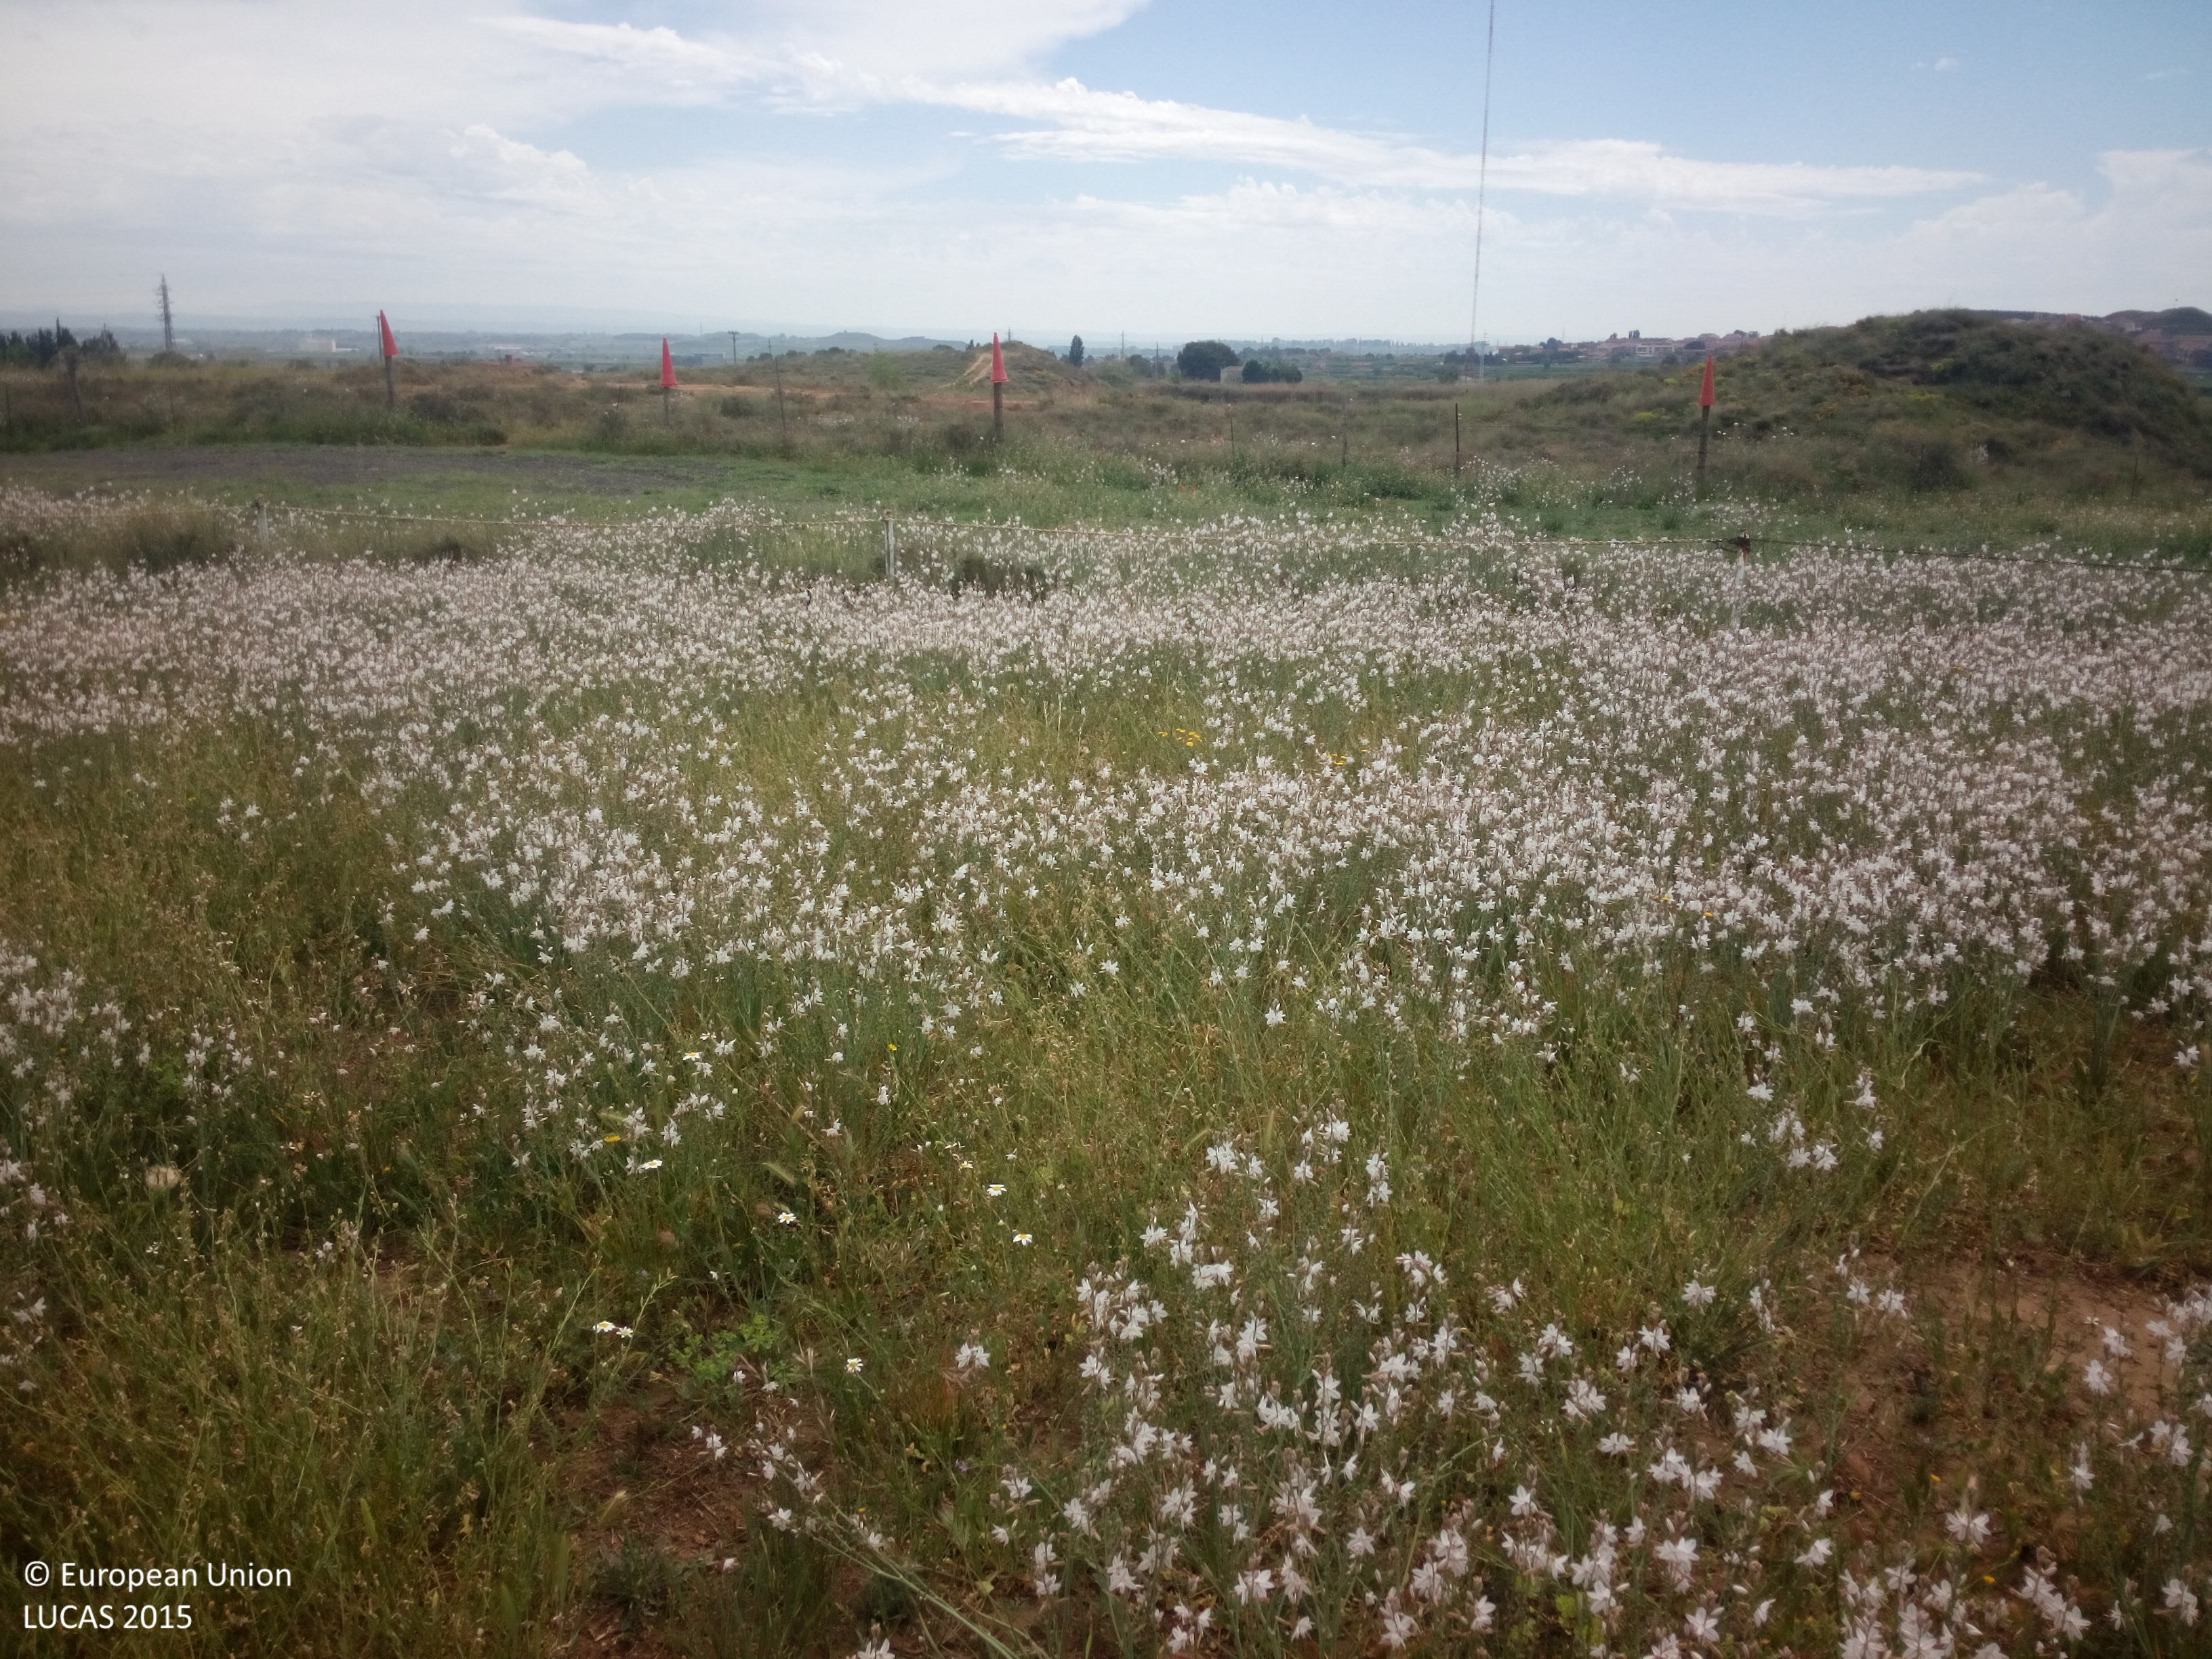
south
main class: Grassland
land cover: Grassland without tree/shrub cover
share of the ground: > 75 %
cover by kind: herbaceous plants 95 %, unconsolidated bare surface 5 %
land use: Semi-natural and natural areas not in use
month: April
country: ES
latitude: 41.6624
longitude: 0.7043
